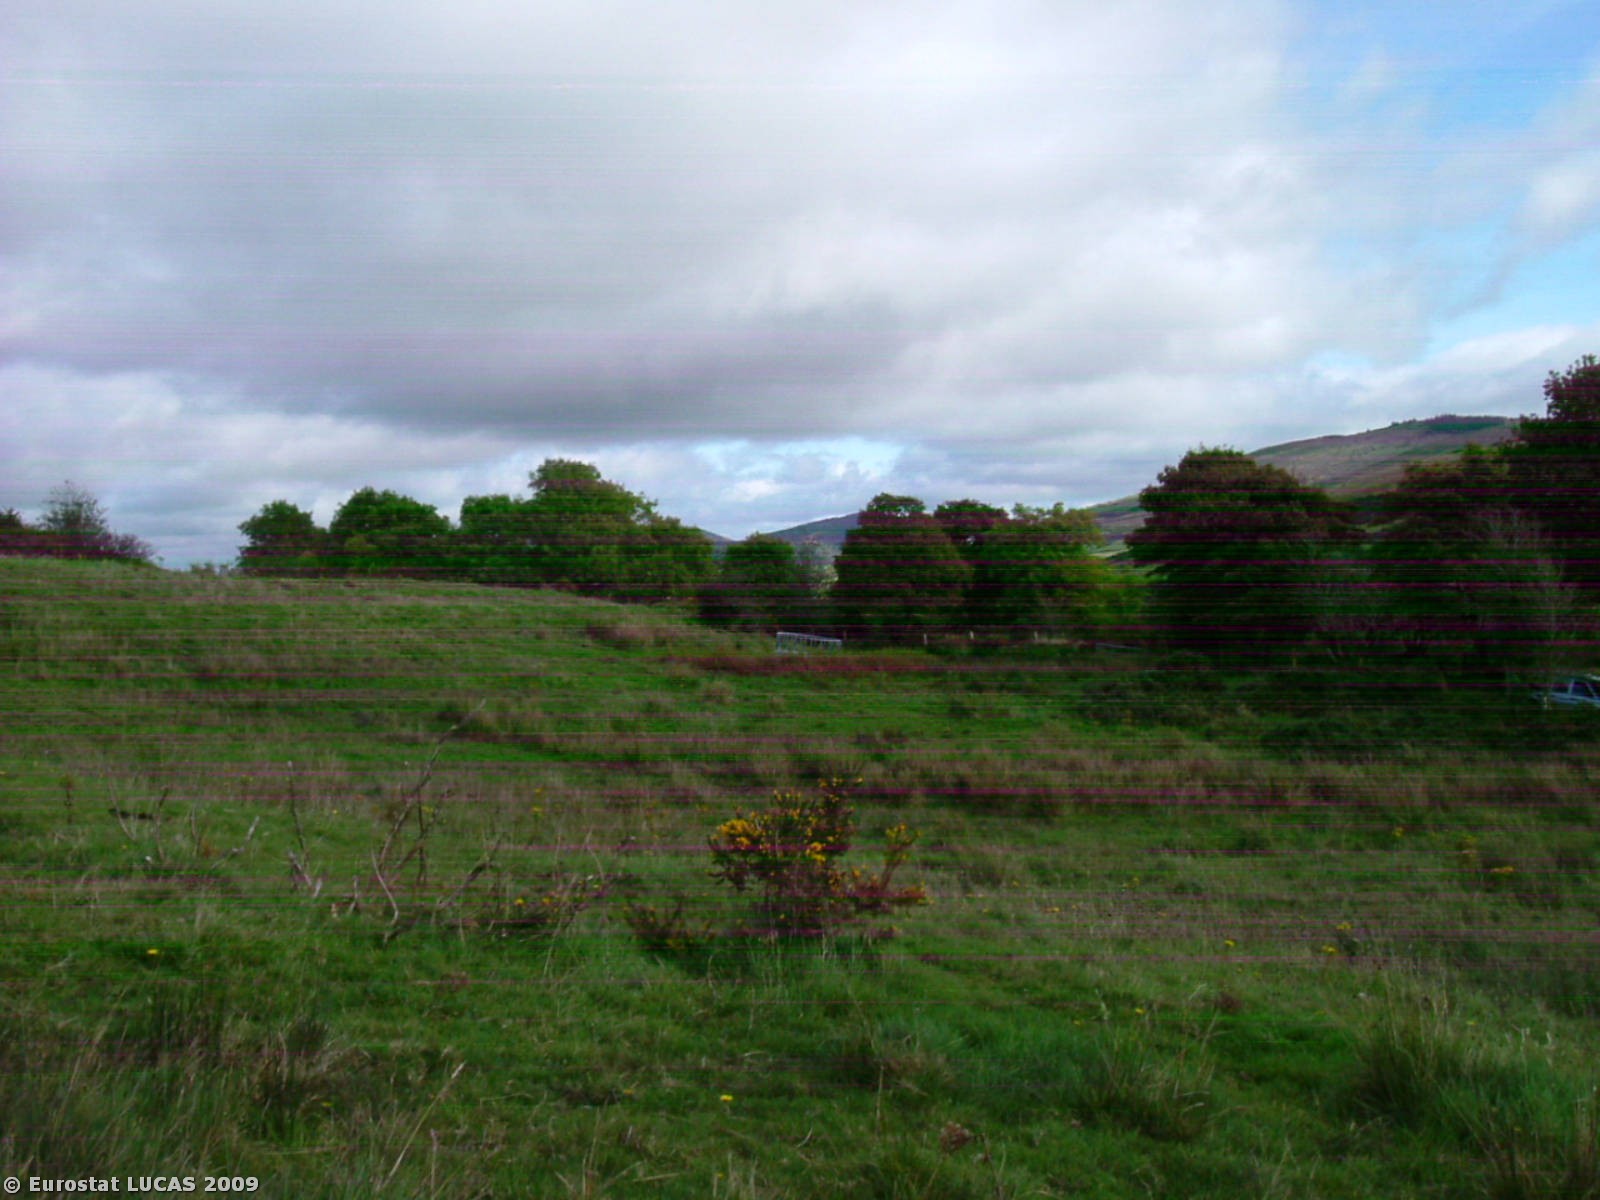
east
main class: Grassland
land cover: Grassland without tree/shrub cover
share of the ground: > 75 %
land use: Agriculture (excluding fallow land and kitchen gardens)
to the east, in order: Grassland without tree/shrub cover; Fences; Managed hedges; Grass margins; Paved roads, cycling and walking lanes; Grass margins; Managed hedges; Grassland without tree/shrub cover; Managed hedges; Grassland without tree/shrub cover
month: September
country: IE
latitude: 52.7637
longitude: -8.1885
